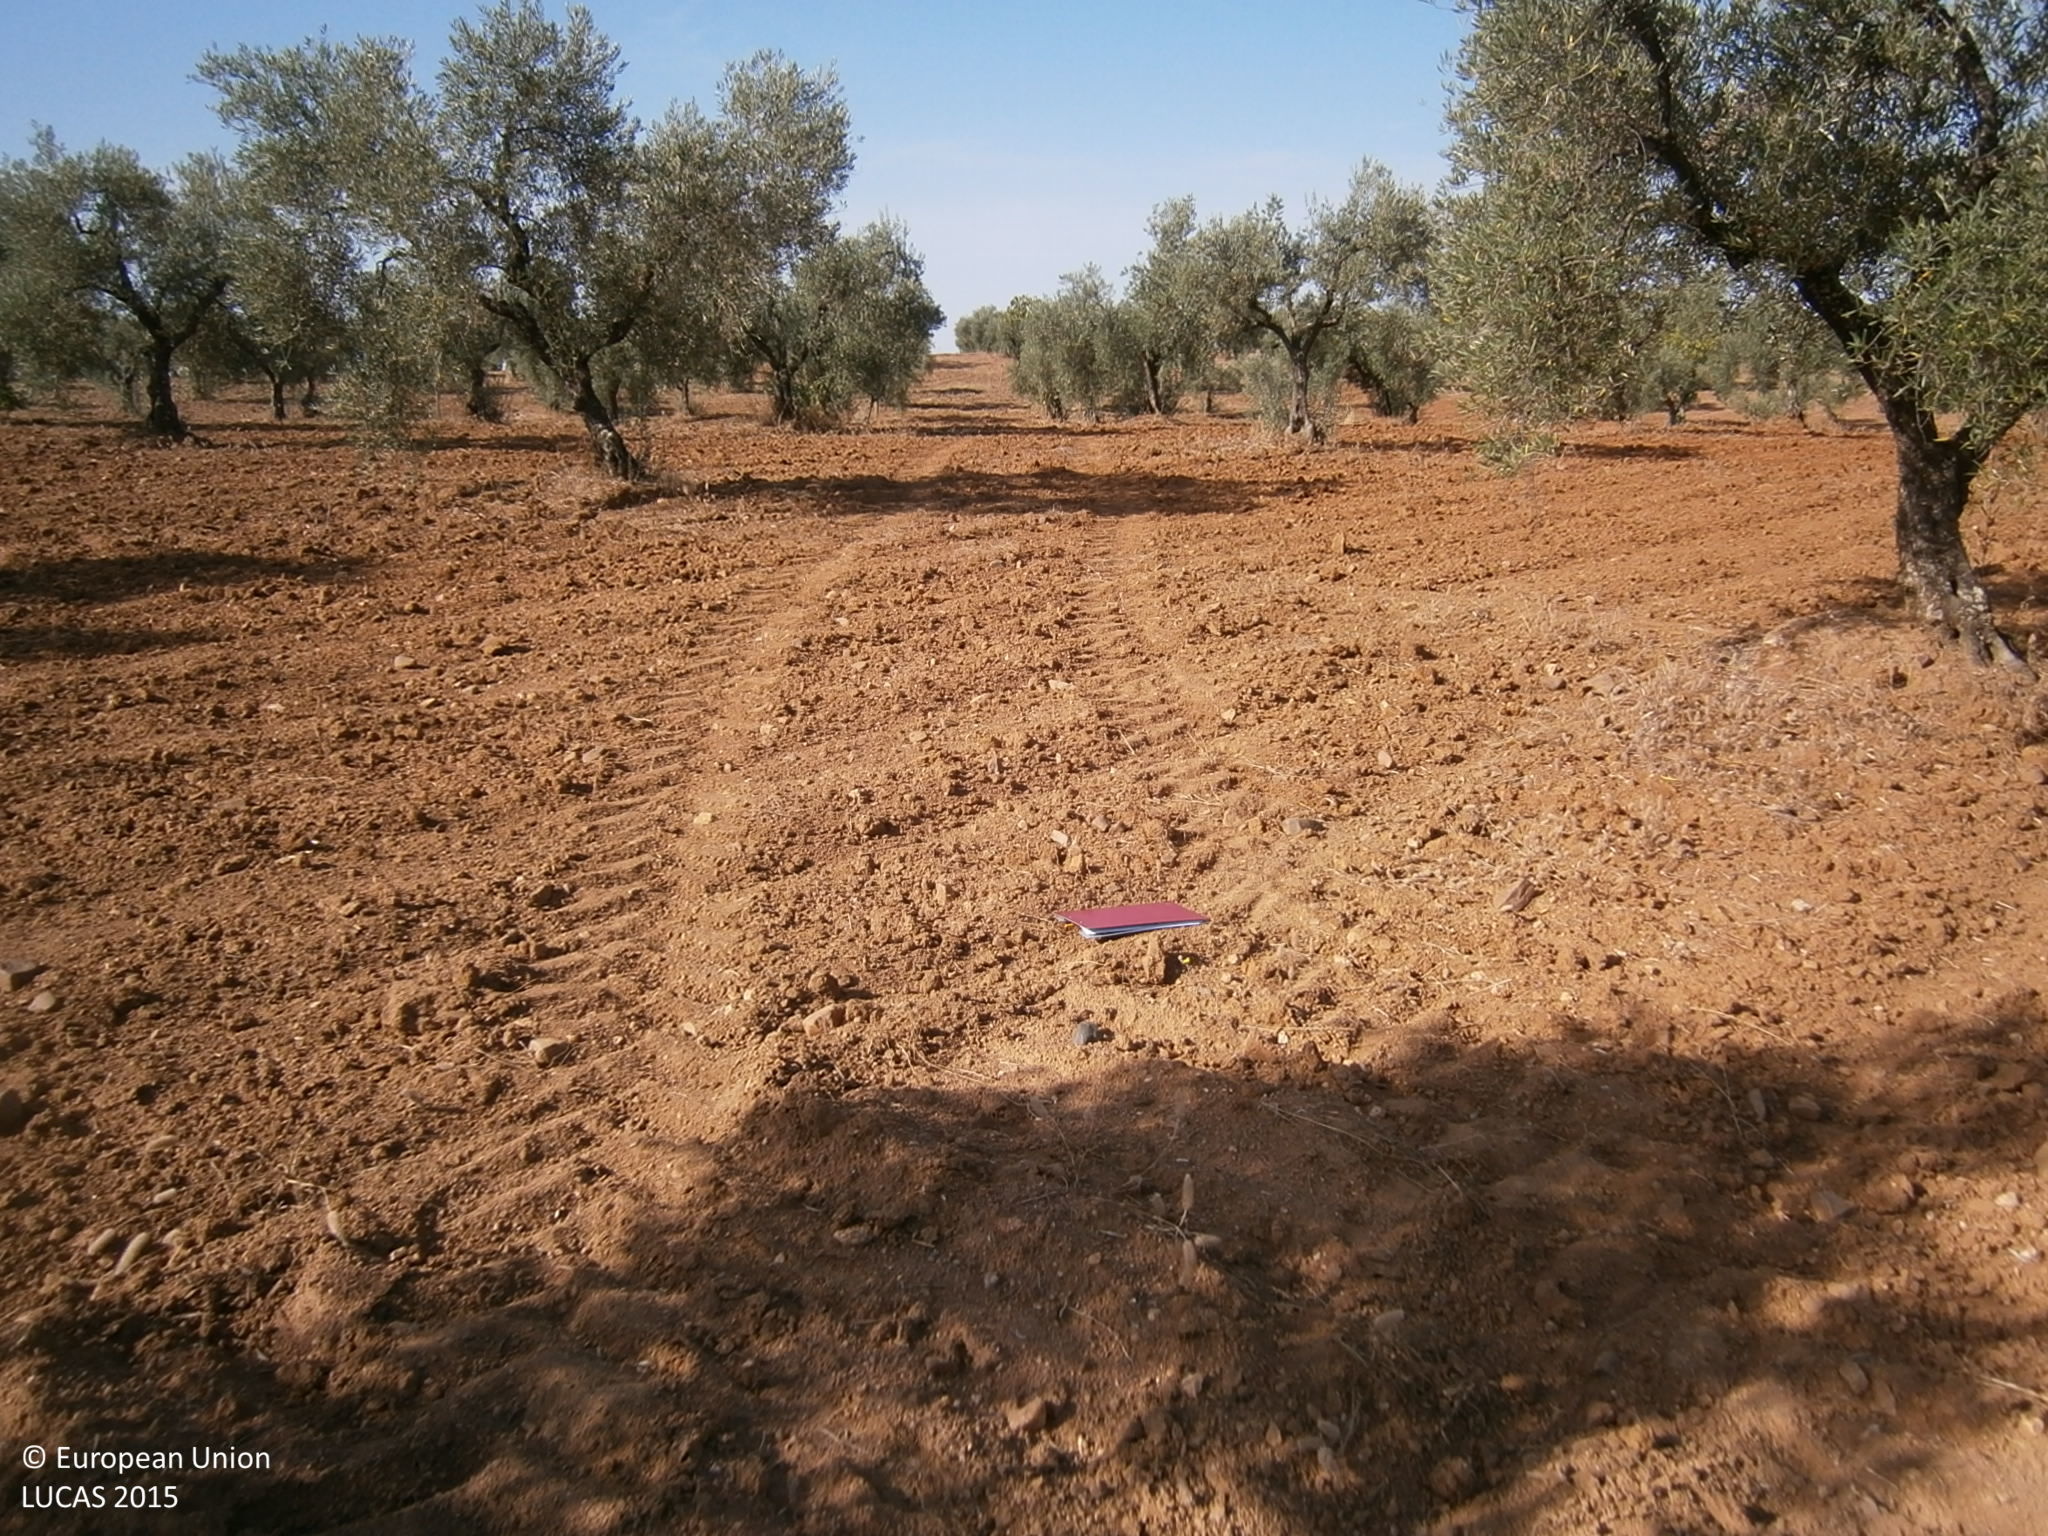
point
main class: Cropland
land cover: Olive groves
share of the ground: 25 - 50 %
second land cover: Other bare soil
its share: > 75 %
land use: Agriculture (excluding fallow land and kitchen gardens)
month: July
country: ES
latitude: 39.0605
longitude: -6.7208
